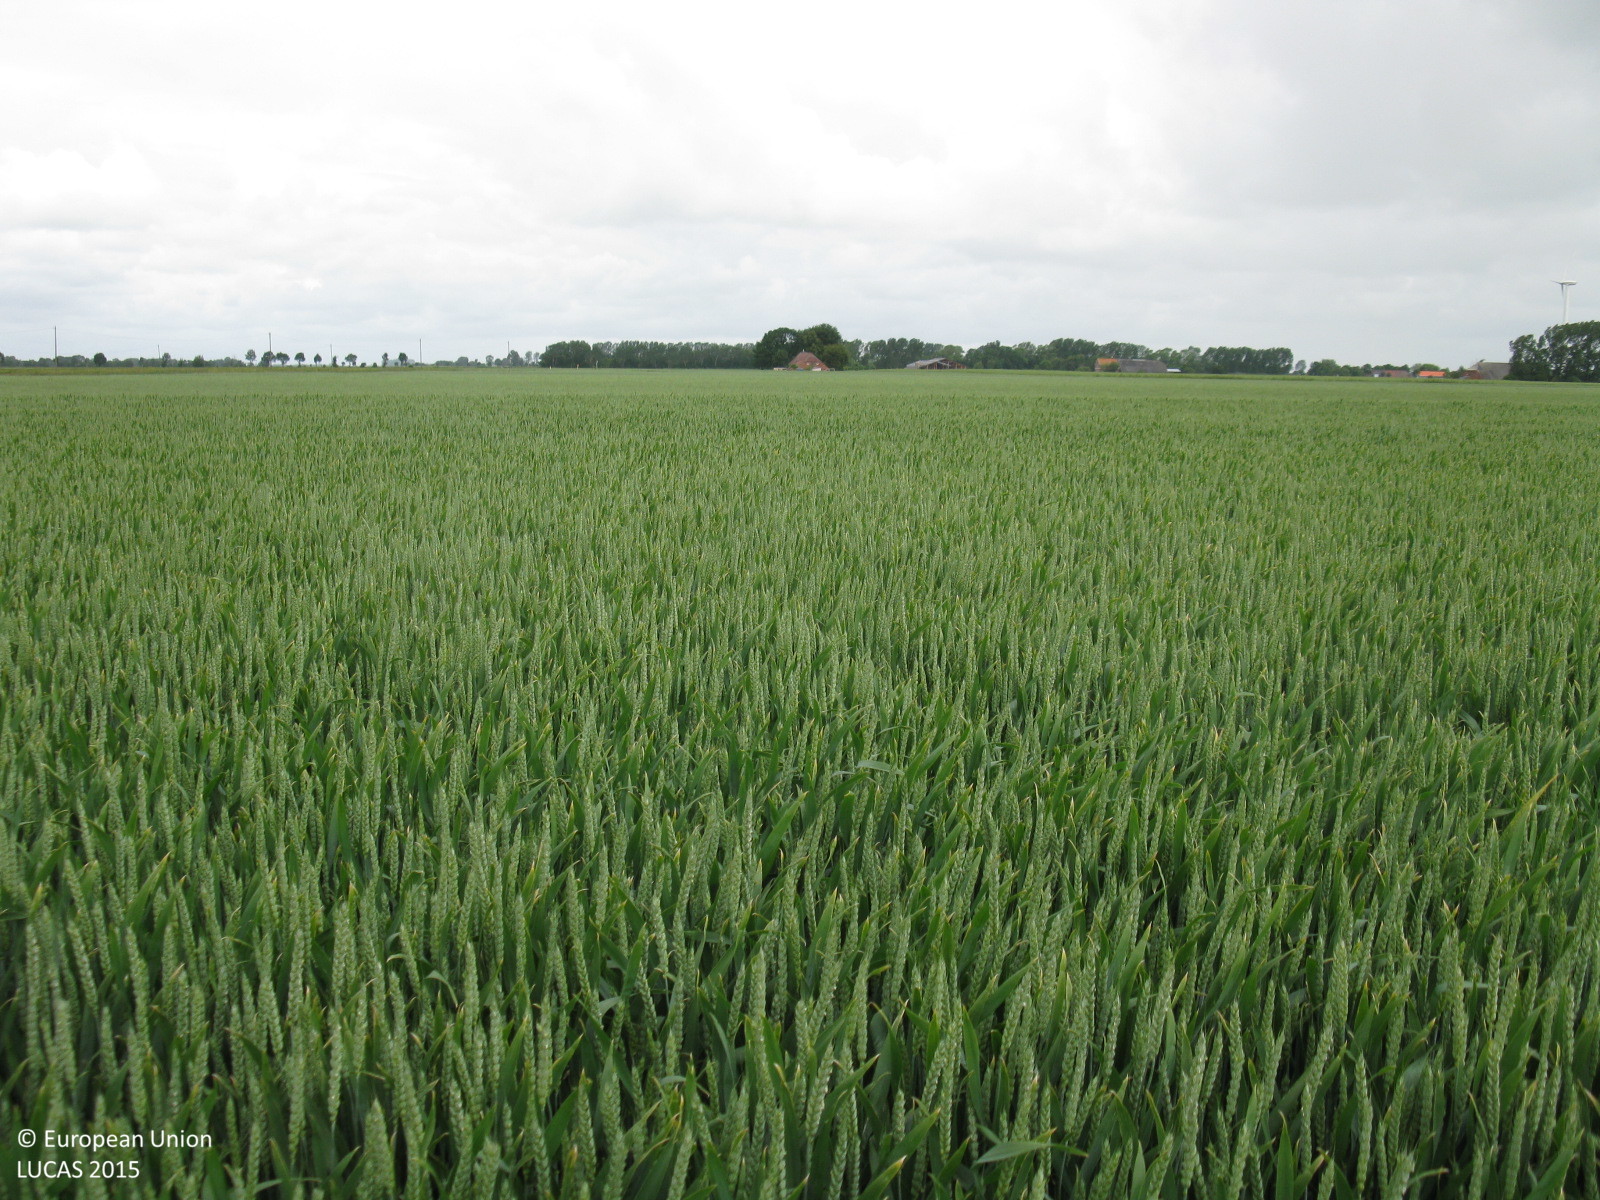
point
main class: Cropland
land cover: Common wheat
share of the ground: > 75 %
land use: Agriculture (excluding fallow land and kitchen gardens)
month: June
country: DE
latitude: 53.3721
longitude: 7.3102
